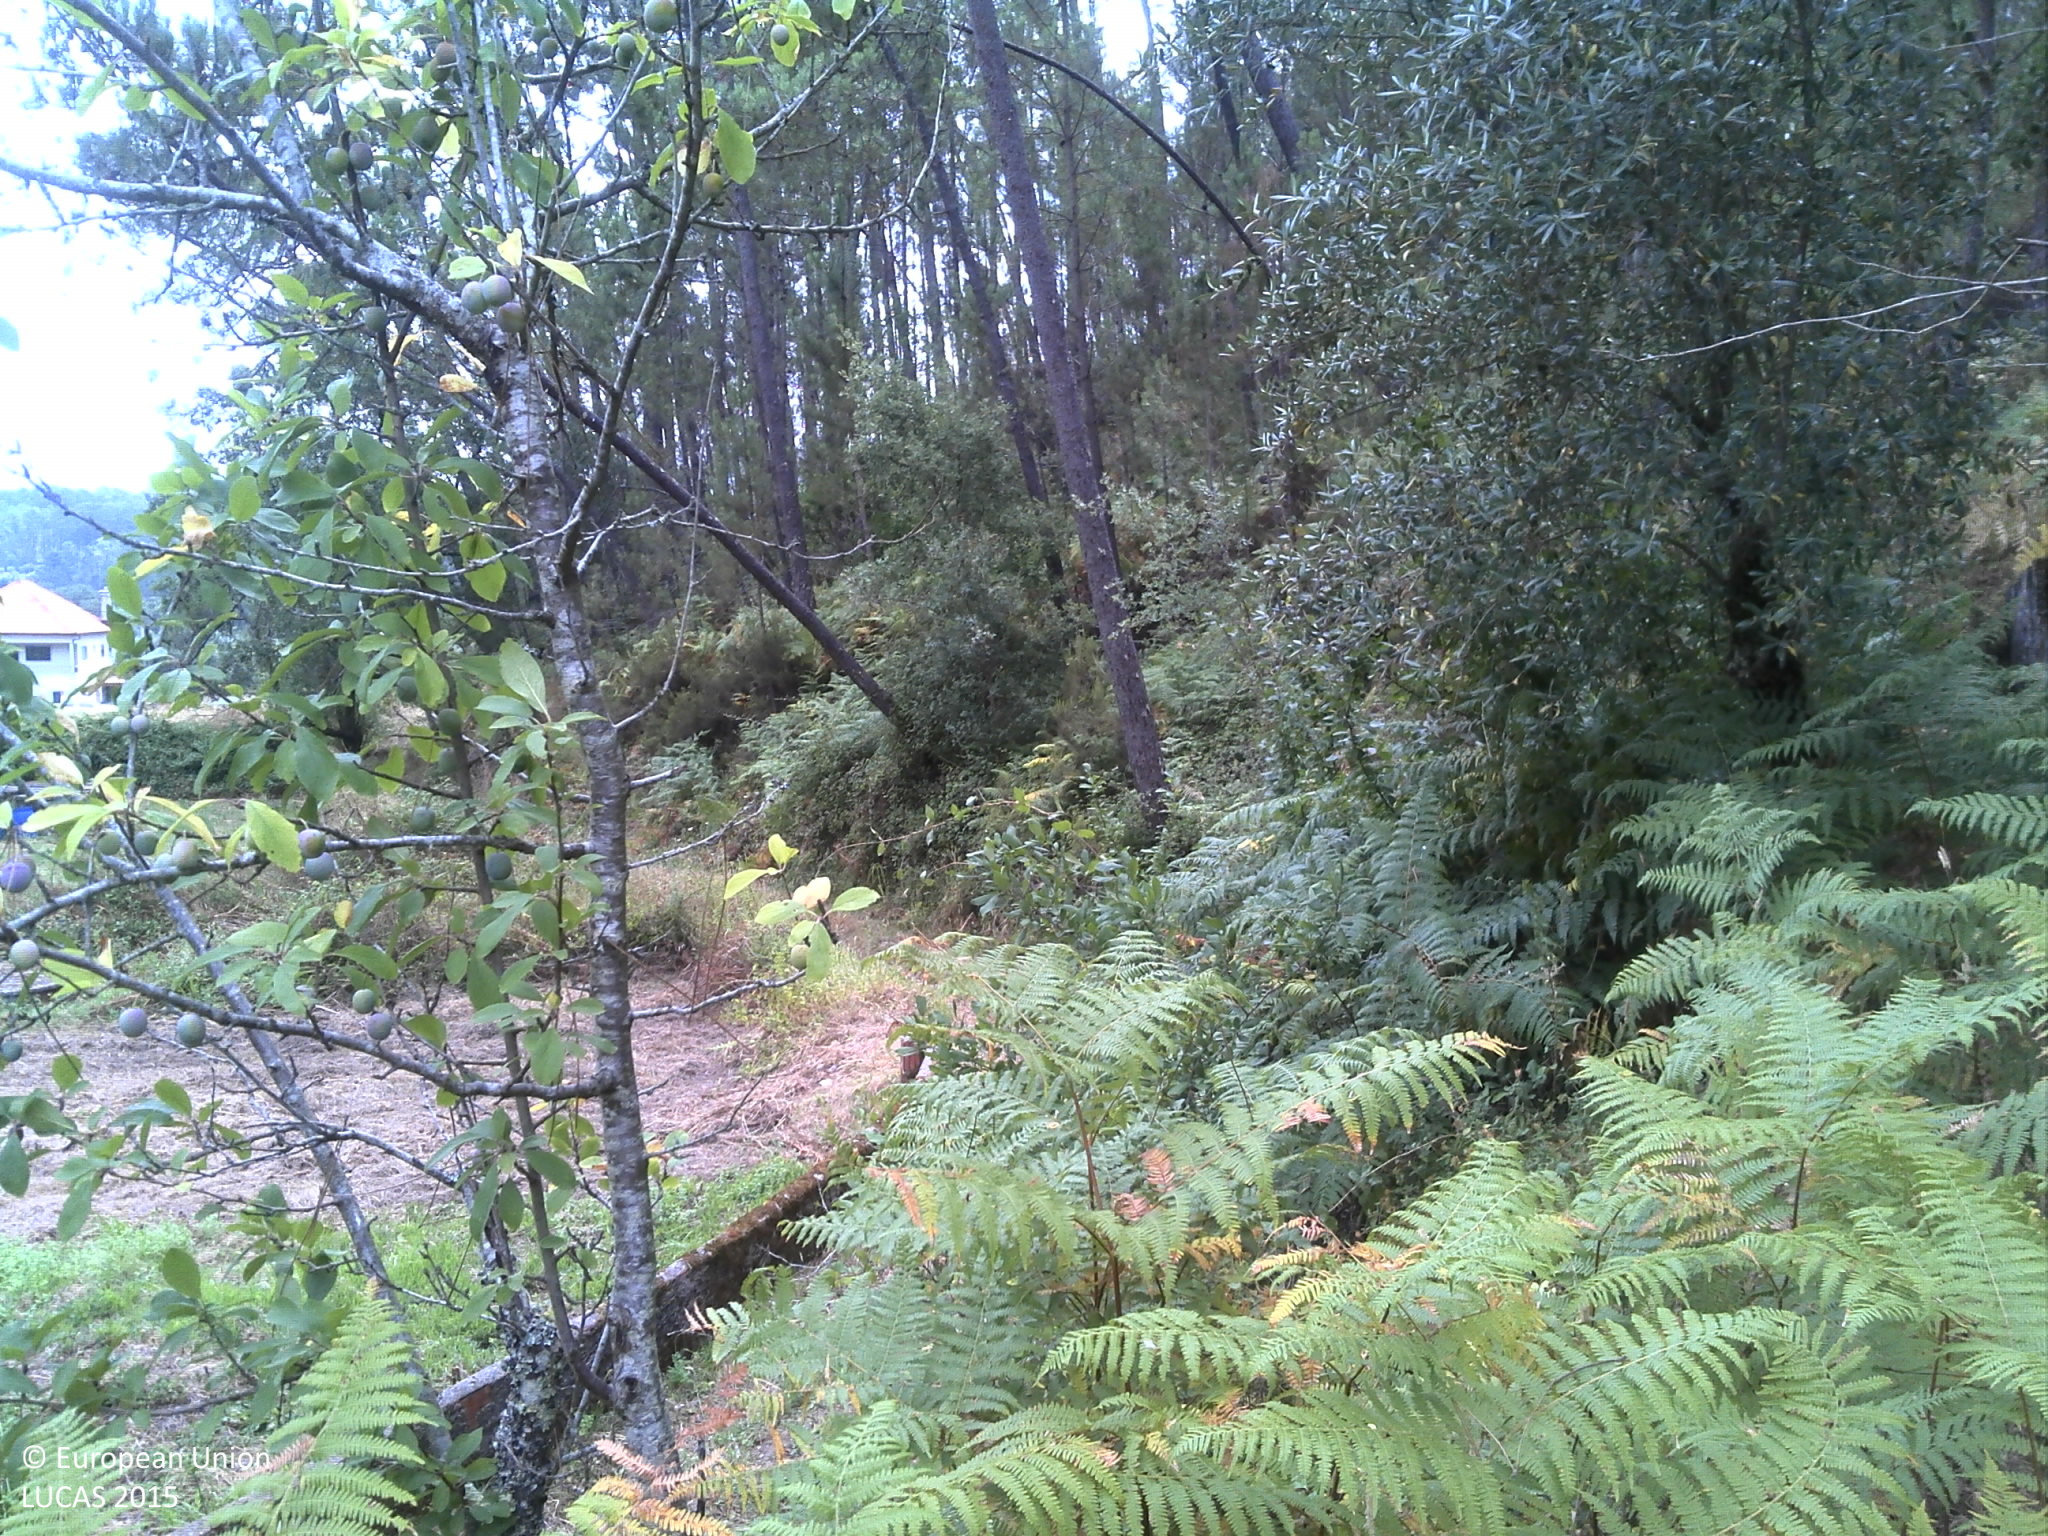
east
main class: Woodland
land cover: Pine dominated coniferous woodland
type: coniferous forest of the mediterranean region
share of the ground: 25 - 50 %
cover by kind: coniferous forest trees 40 %, shrubs 20 %, herbaceous plants 20 %, unconsolidated bare surface 10 %
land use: Forestry
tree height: > 5 m
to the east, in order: Pine dominated coniferous woodland; Grassland without tree/shrub cover; Artificial constructions in urban areas; Olive groves; Artificial constructions in urban areas
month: July
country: PT
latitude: 39.8265
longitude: -8.4800
